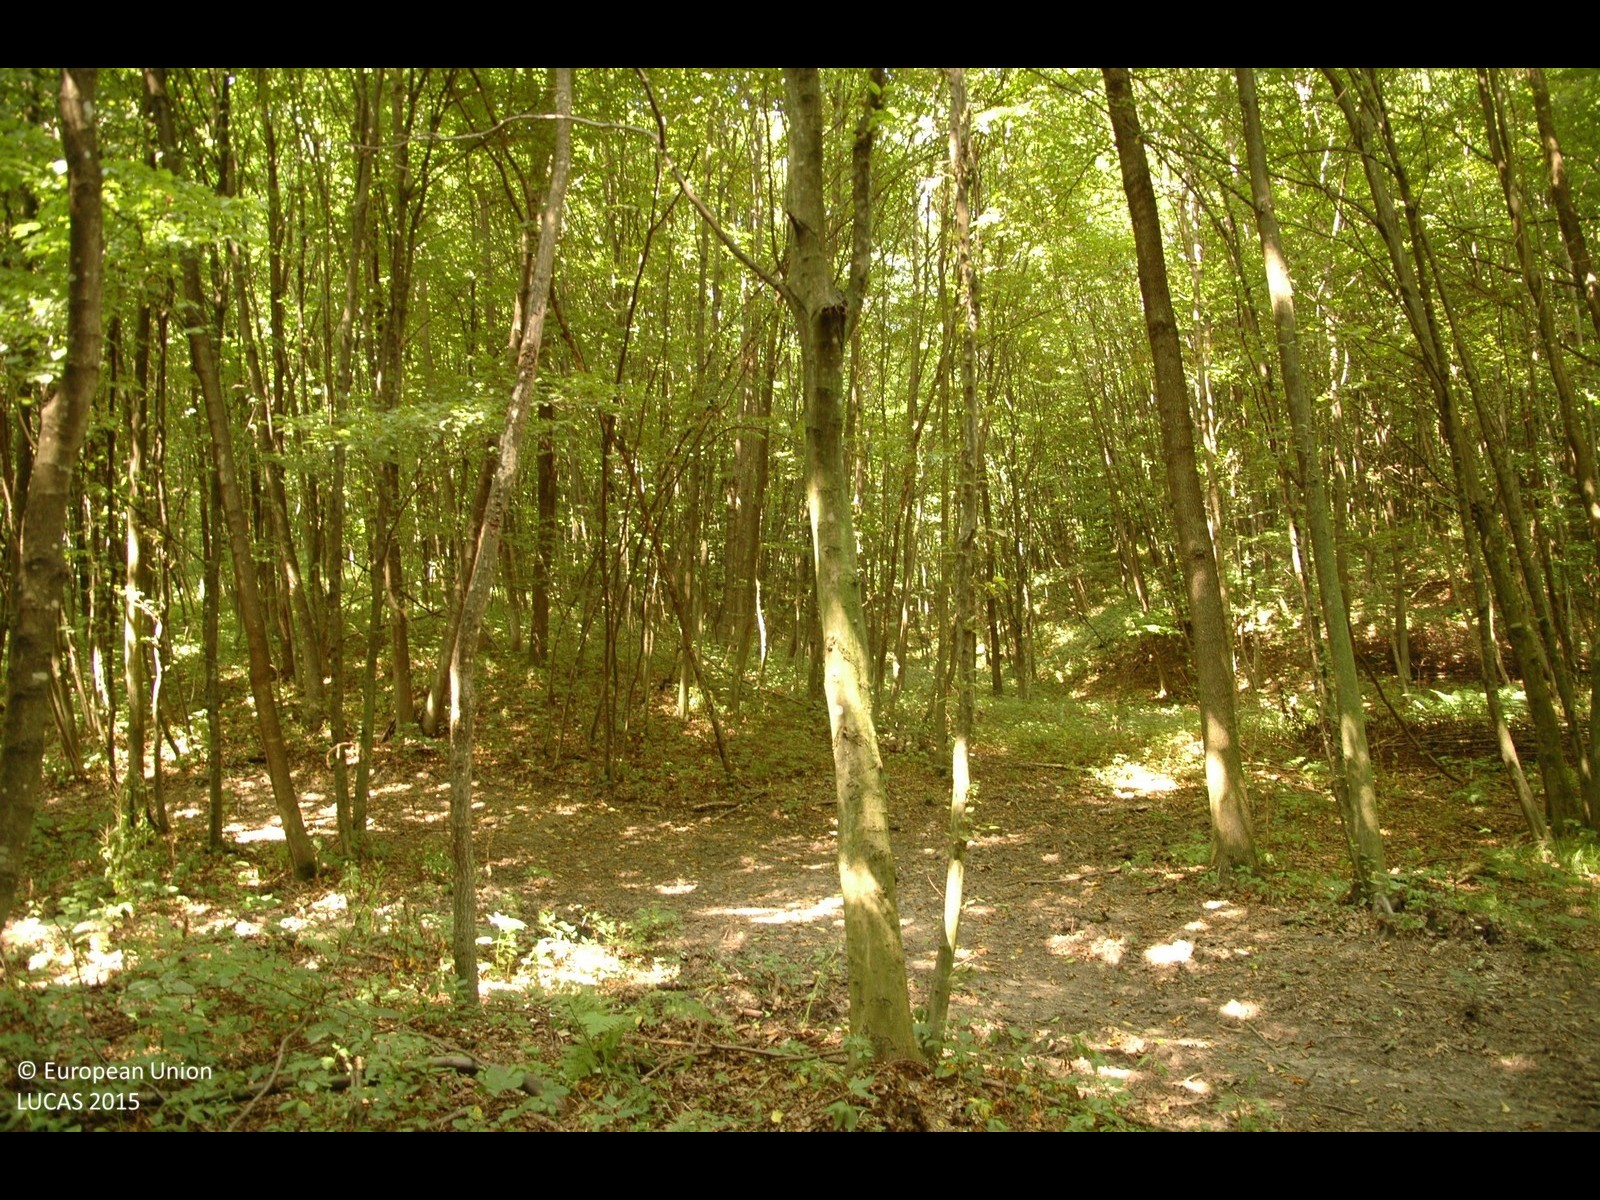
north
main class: Woodland
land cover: Broadleaved woodland
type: mesophytic deciduous forest
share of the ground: > 75 %
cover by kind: broadleaved forest trees 100 %
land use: Forestry
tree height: > 5 m
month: July
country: HR
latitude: 46.1594
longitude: 16.6958
